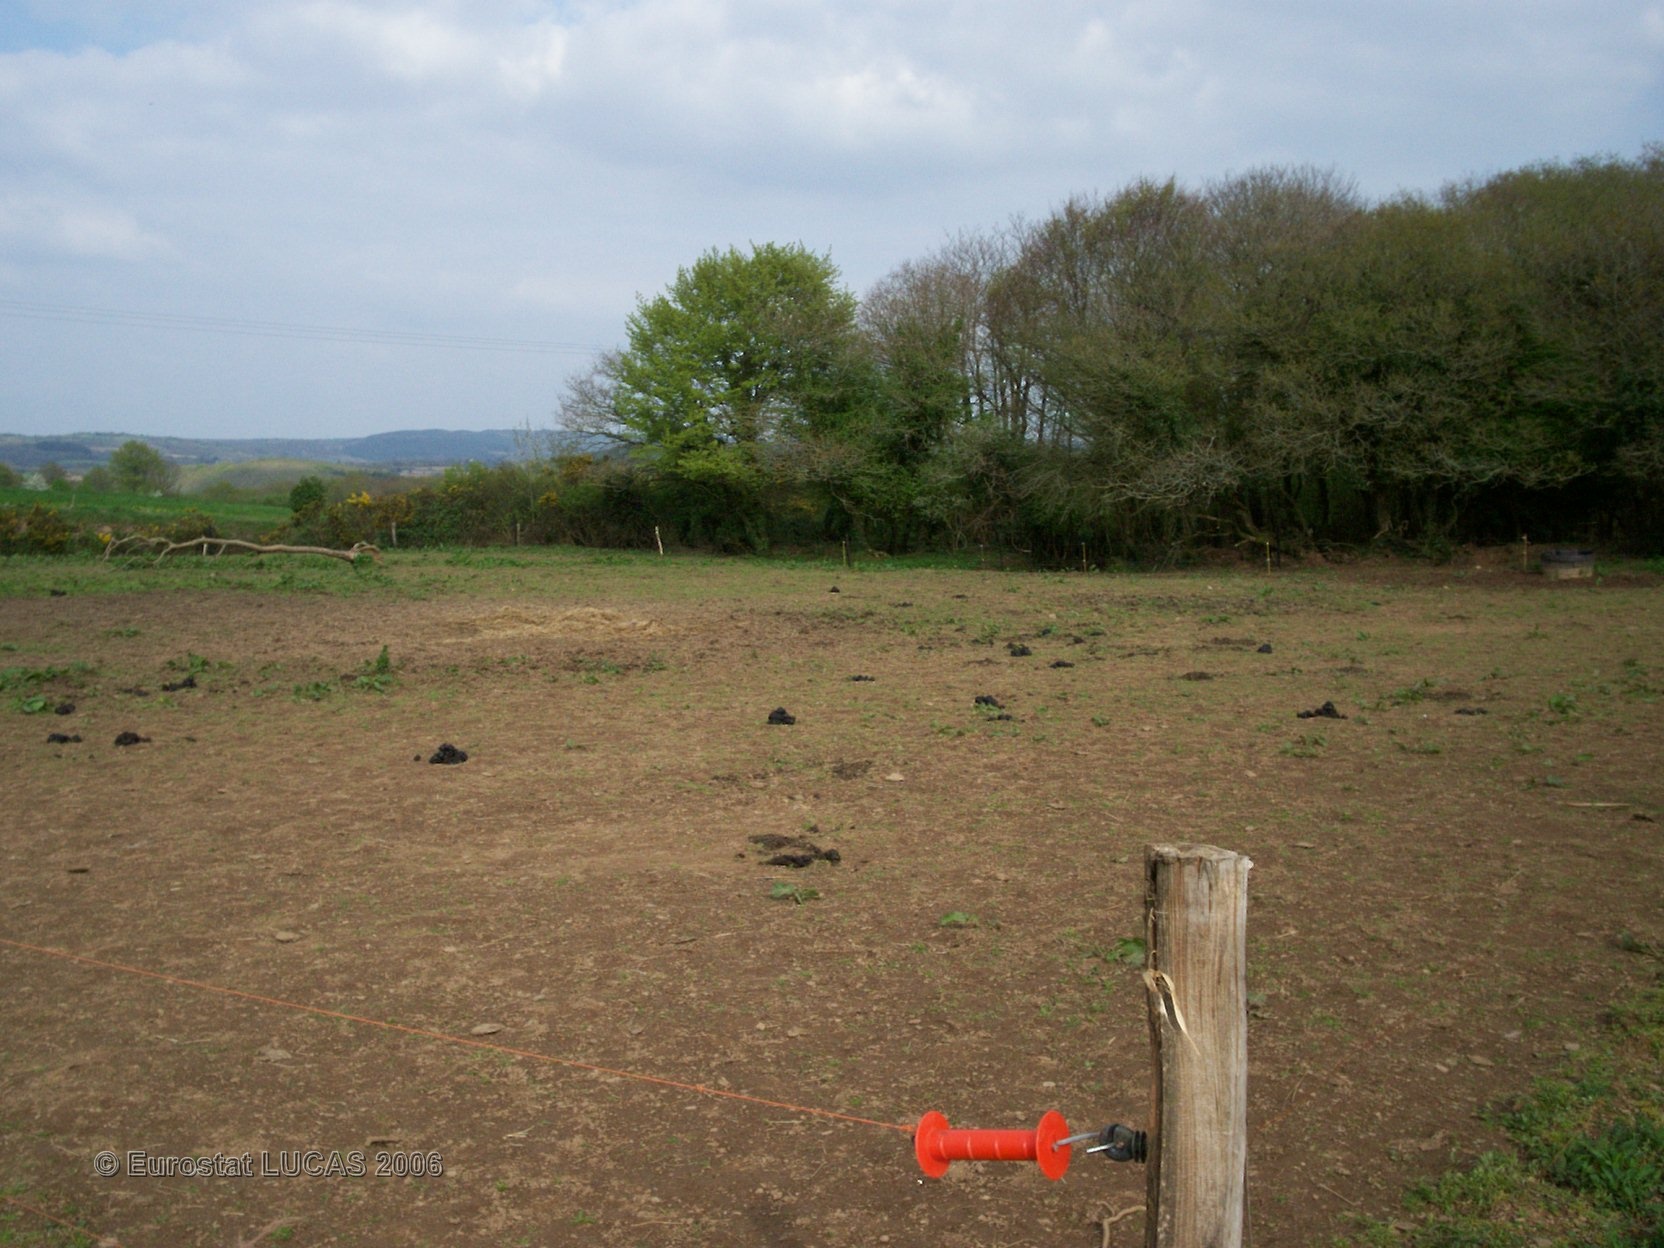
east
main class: Grassland
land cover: Grassland without tree/shrub cover
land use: Agriculture (excluding fallow land and kitchen gardens)
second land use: Amenities, museums, leisure
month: April
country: FR
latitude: 48.3154
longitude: -3.9630
